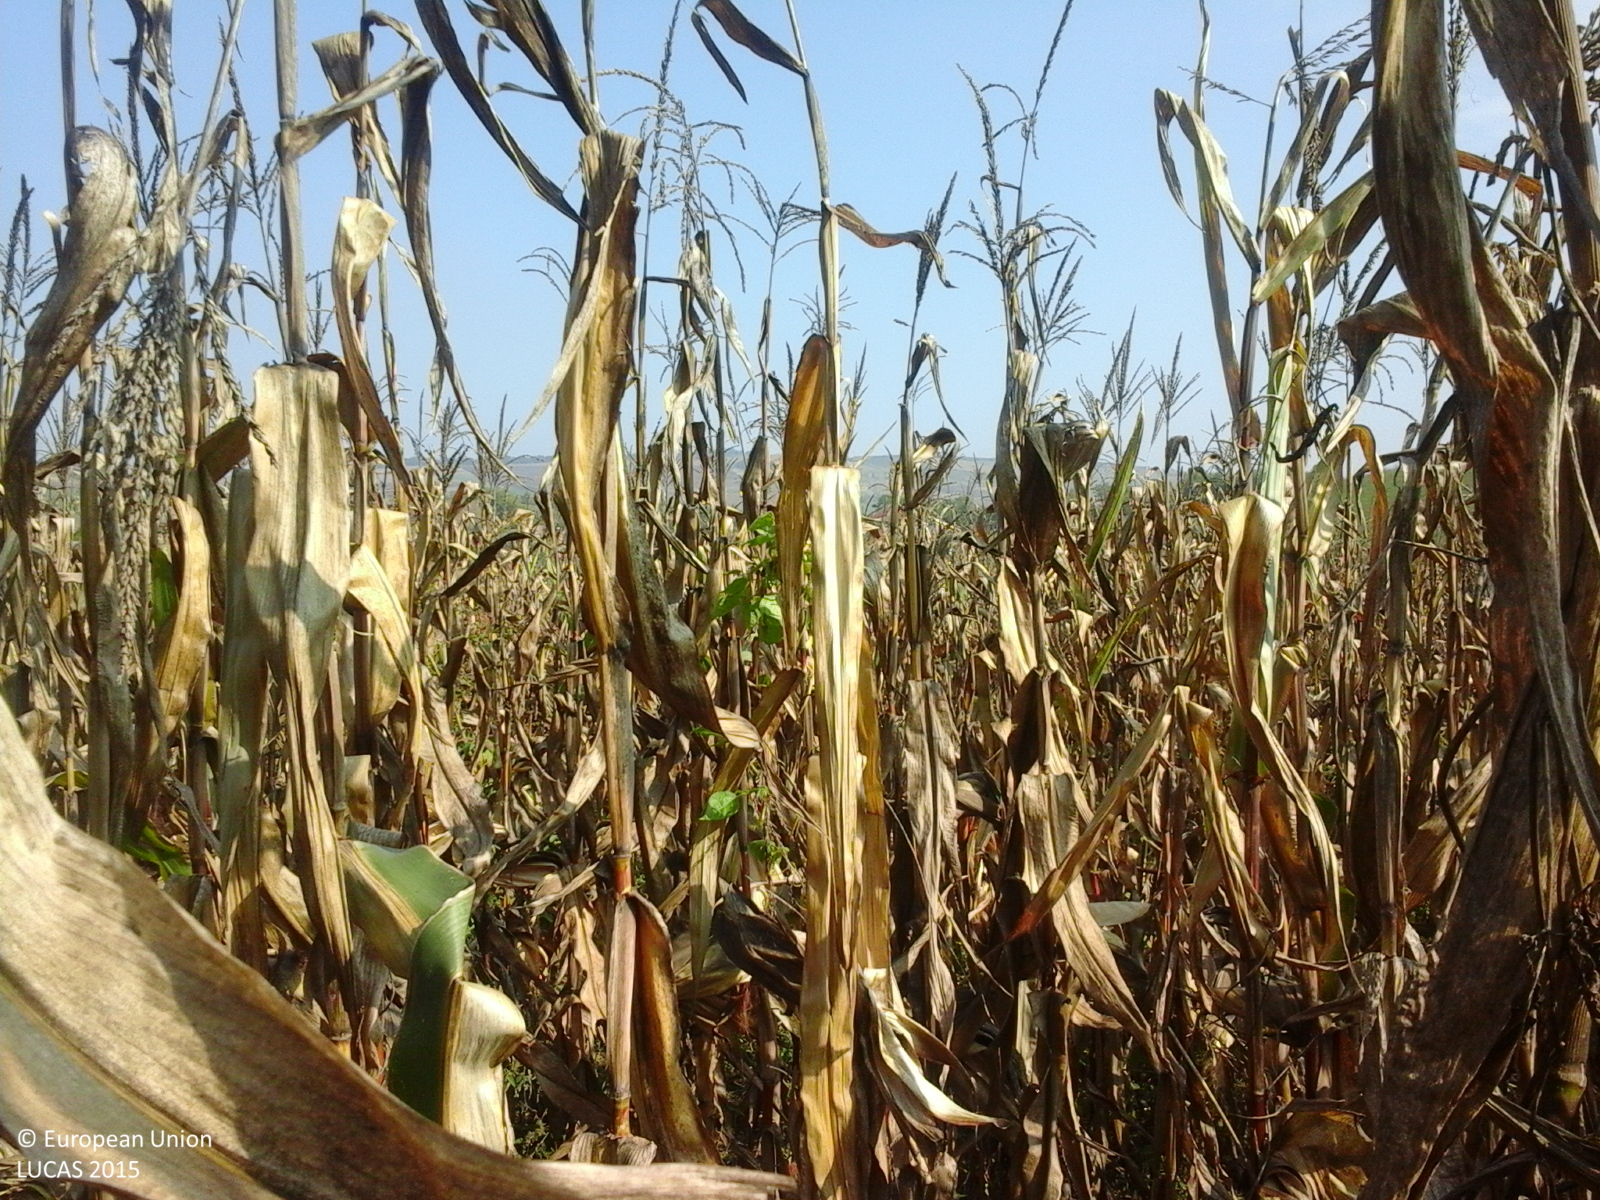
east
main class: Cropland
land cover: Maize
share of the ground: > 75 %
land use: Agriculture (excluding fallow land and kitchen gardens)
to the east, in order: Maize; Spontaneously vegetated surfaces; Ditches and canals; Spontaneously vegetated surfaces; Lucerne; Grassland without tree/shrub cover; Tracks; Grass margins; Lucerne; Maize
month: October
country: RO
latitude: 46.5588
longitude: 24.1285
